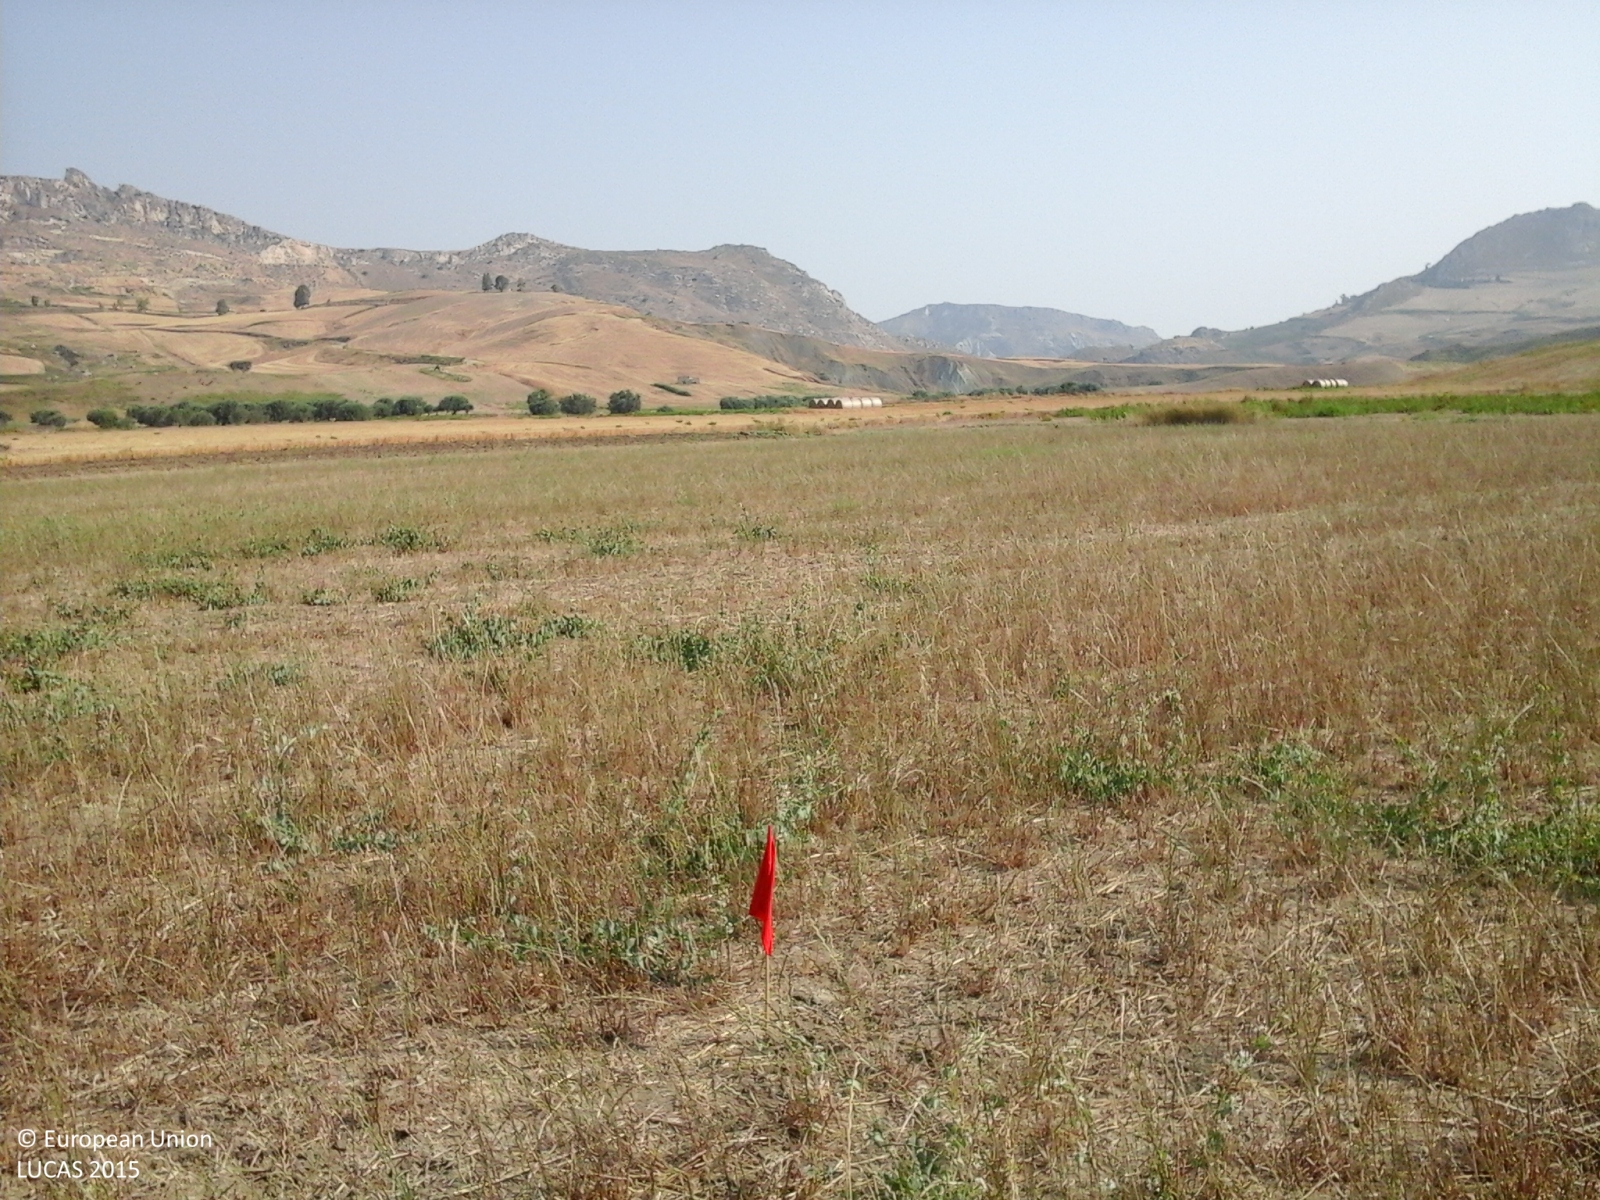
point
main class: Cropland
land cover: Durum wheat
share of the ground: > 75 %
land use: Agriculture (excluding fallow land and kitchen gardens)
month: July
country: IT
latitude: 37.1912
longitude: 13.9904
